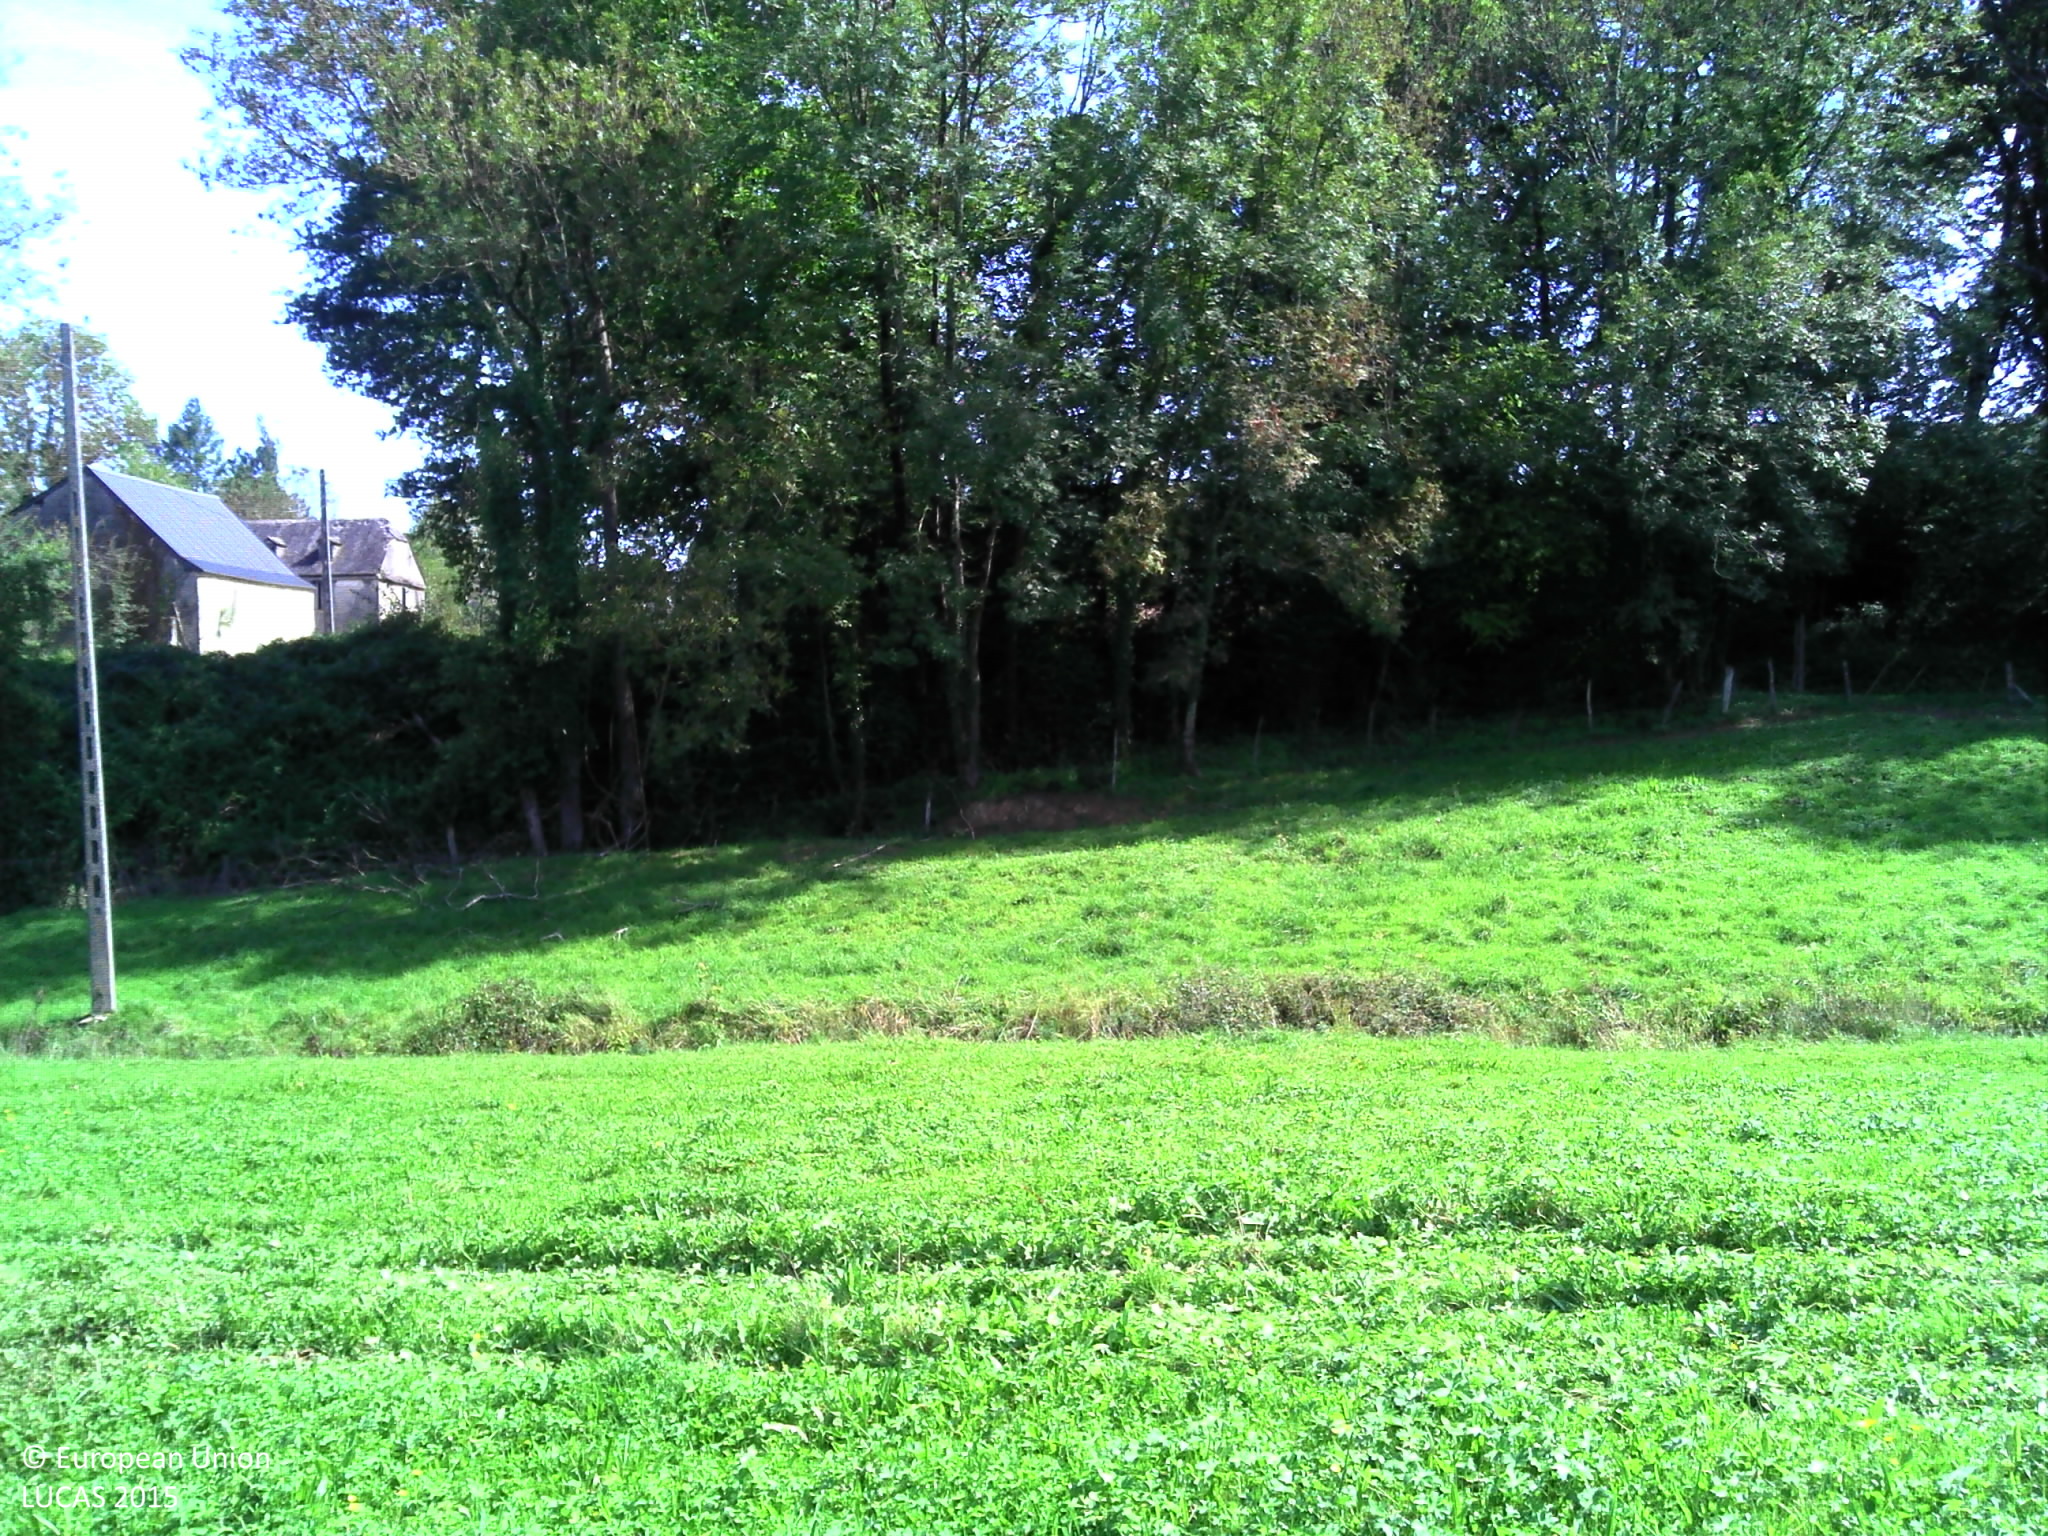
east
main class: Grassland
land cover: Grassland without tree/shrub cover
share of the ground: > 75 %
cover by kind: herbaceous plants 100 %
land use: Agriculture (excluding fallow land and kitchen gardens)
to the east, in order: Grassland without tree/shrub cover; Rivers and streams; Grassland without tree/shrub cover; Ditches and canals; Fences; Broadleaved woodland; Grass margins; Paved roads, cycling and walking lanes; Ditches and canals; Electric lines; Spontaneously vegetated surfaces; Fences; Grassland without tree/shrub cover; Electric lines; Grassland with sparse tree/shrub cover; Fences; Electric lines; Ditches and canals; Grass margins; Paved roads, cycling and walking lanes; Grass margins
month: September
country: FR
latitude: 43.1316
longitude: -0.6164
